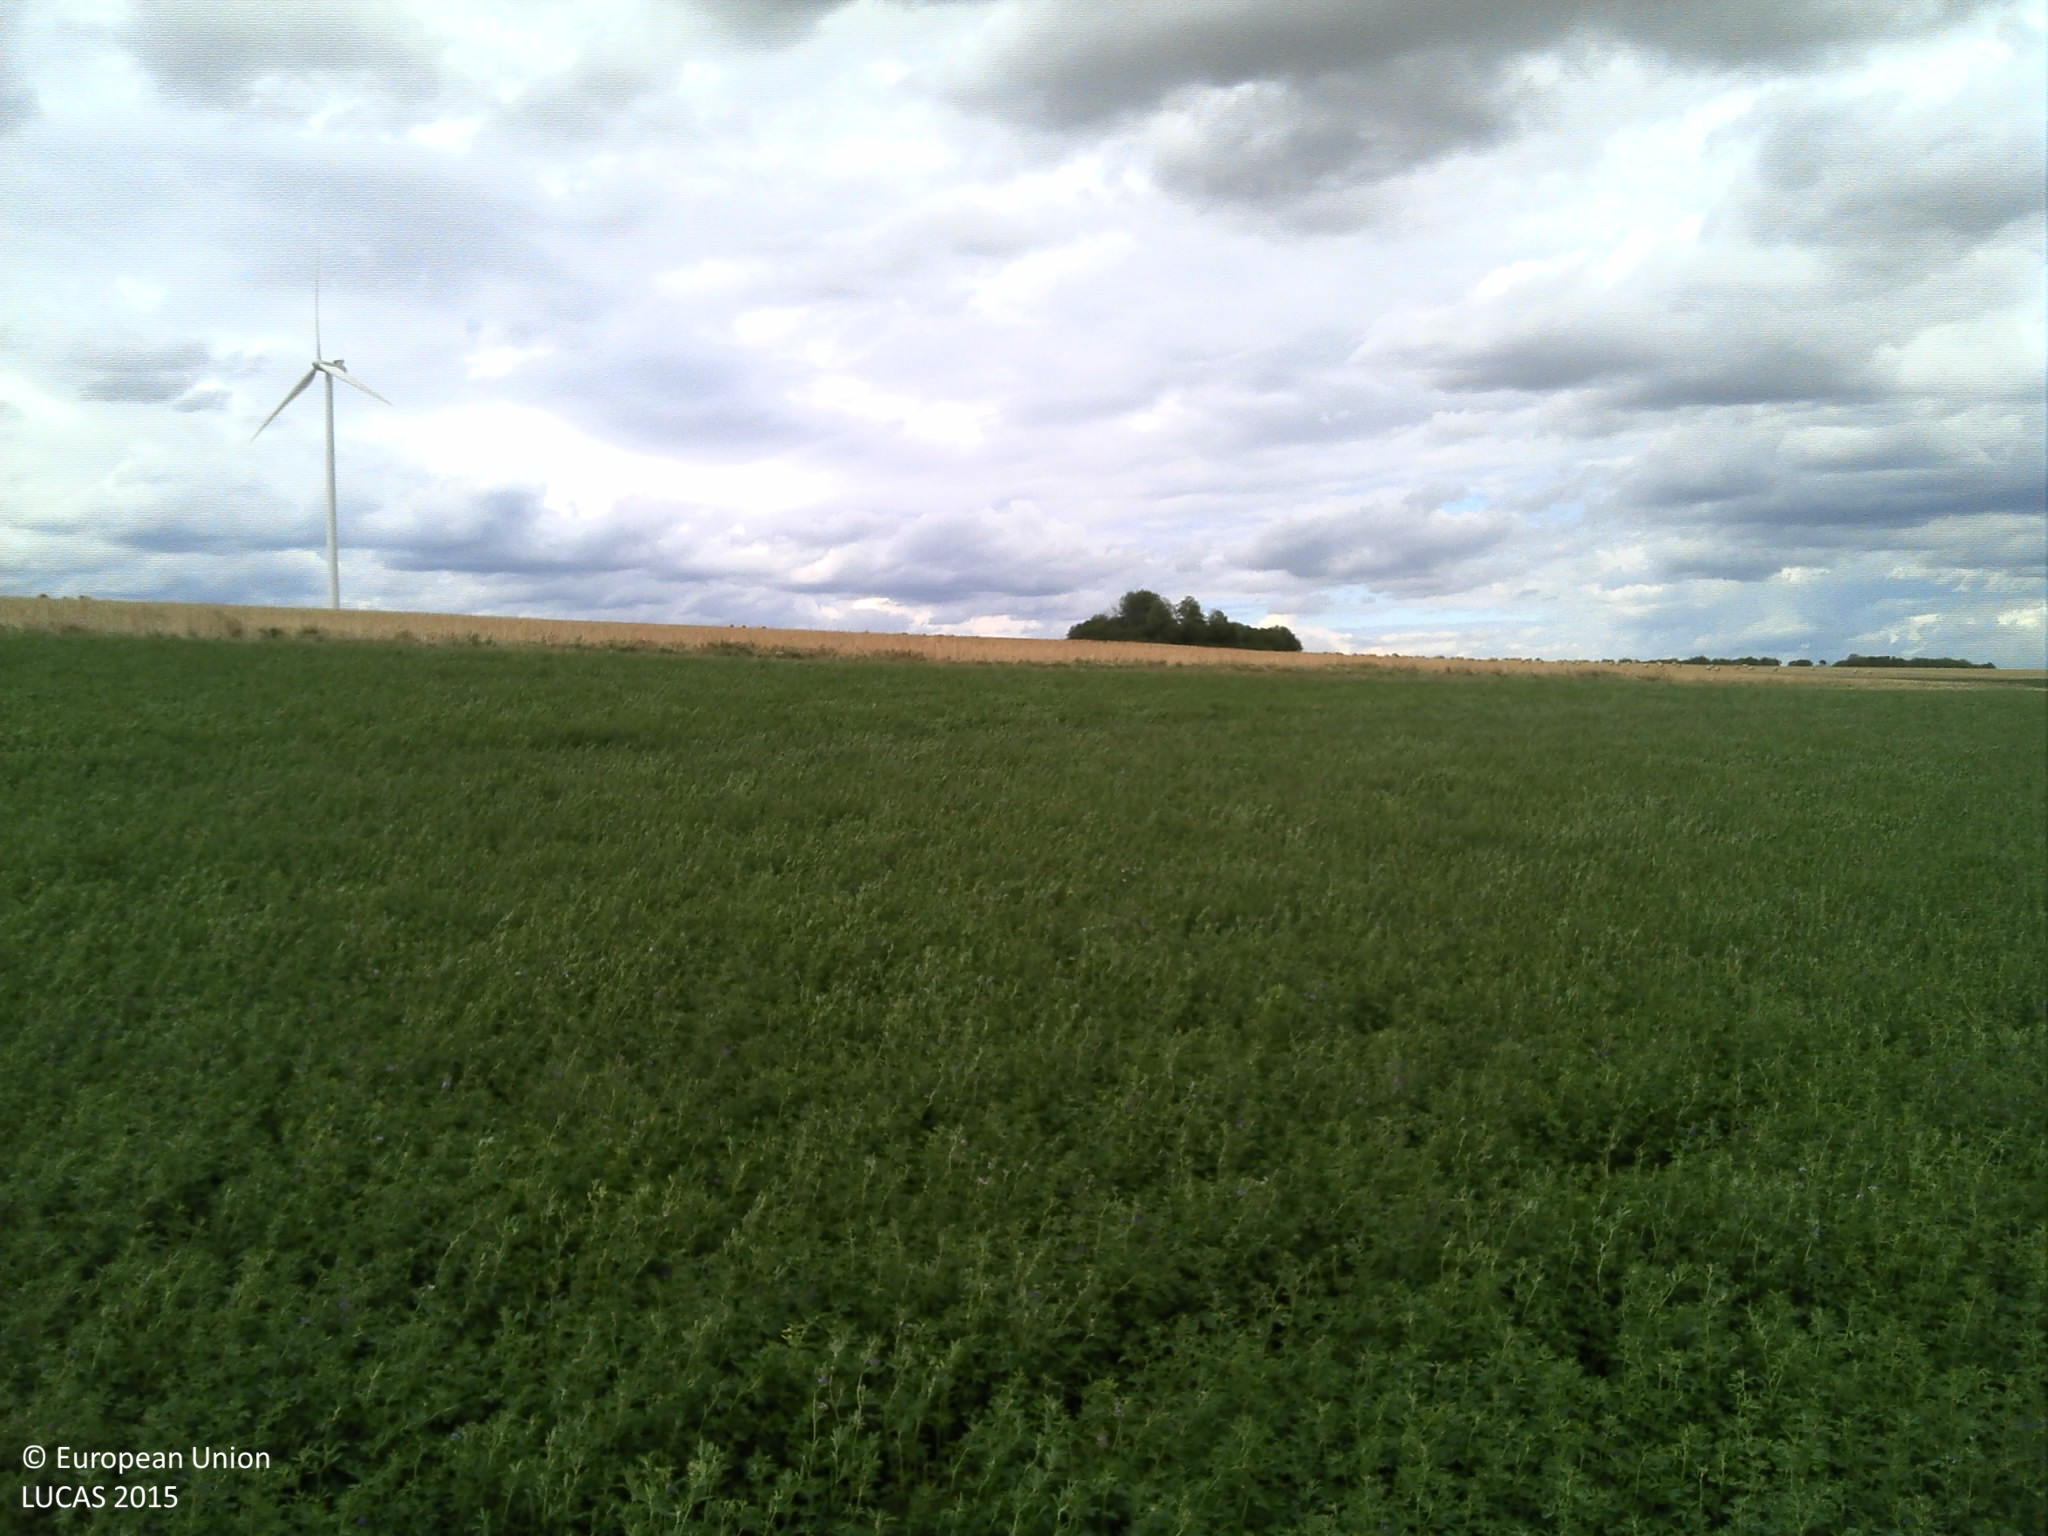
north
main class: Cropland
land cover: Lucerne
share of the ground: > 75 %
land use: Agriculture (excluding fallow land and kitchen gardens)
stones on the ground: < 10 %
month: July
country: FR
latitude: 49.4218
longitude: 4.5234
